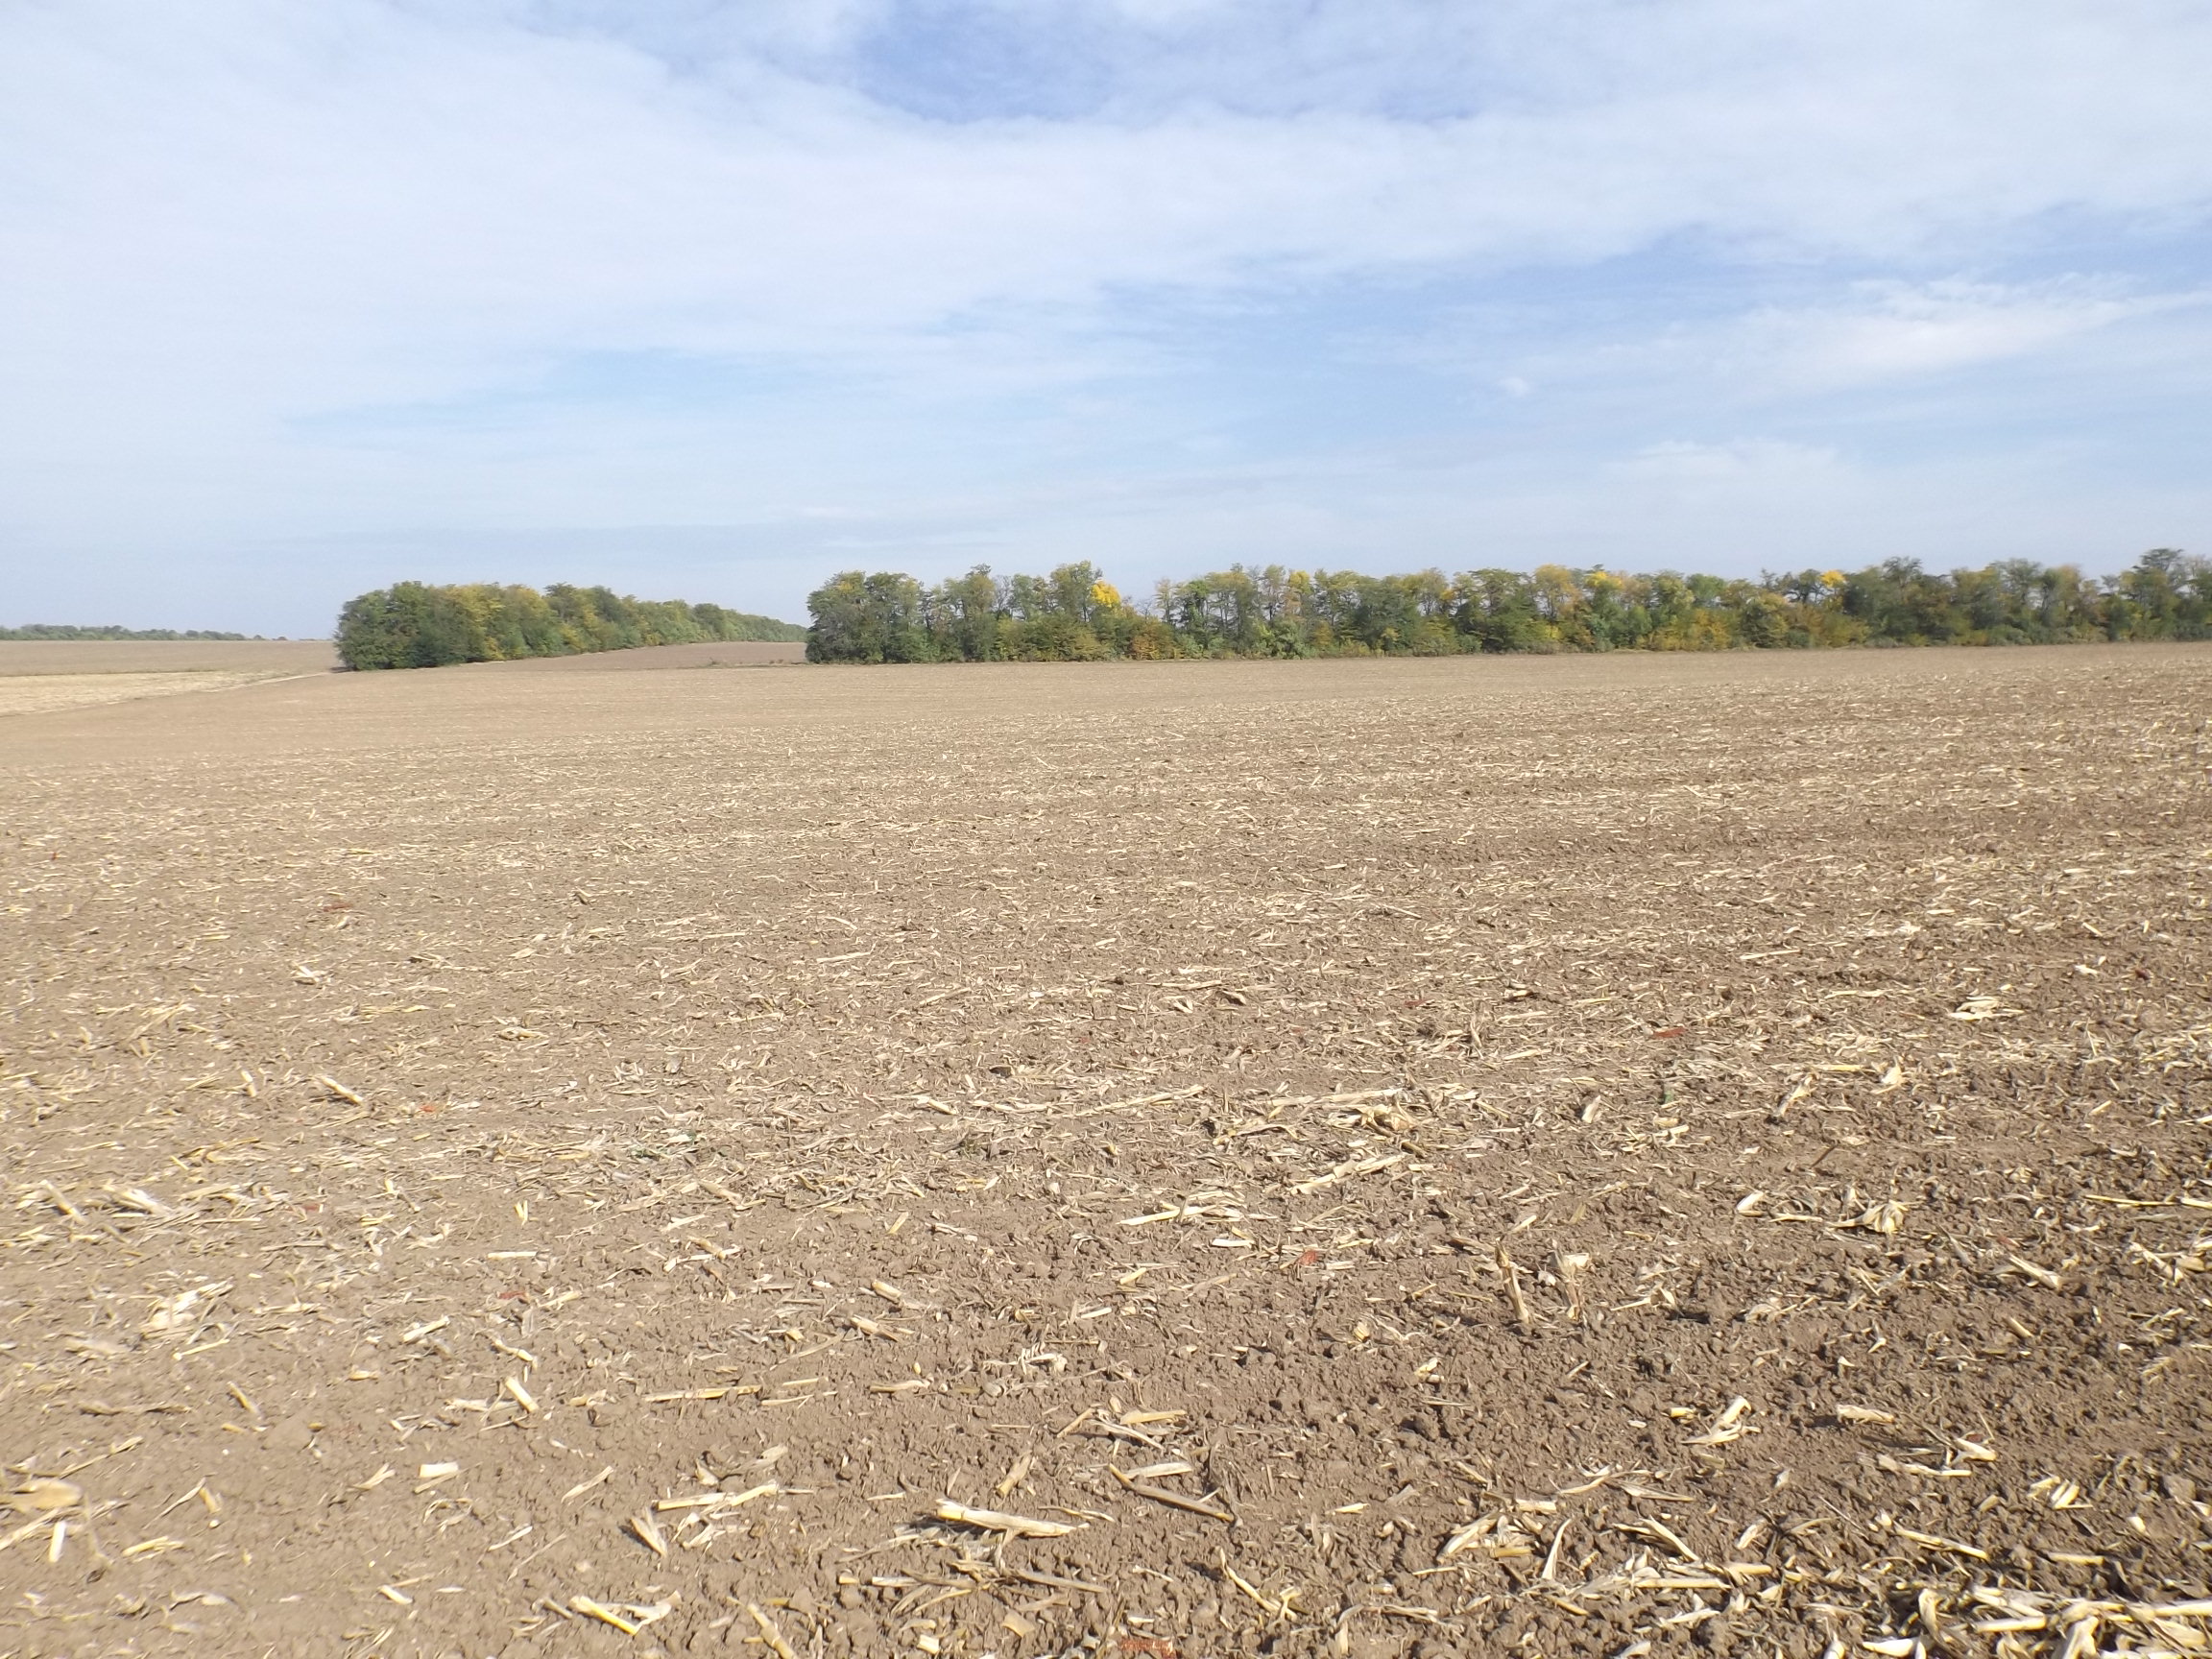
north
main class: Cropland
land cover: Maize
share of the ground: < 10 %
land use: Agriculture (excluding fallow land and kitchen gardens)
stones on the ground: < 10 %
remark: Harvested field
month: October
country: BG
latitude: 43.9276
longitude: 26.8976
